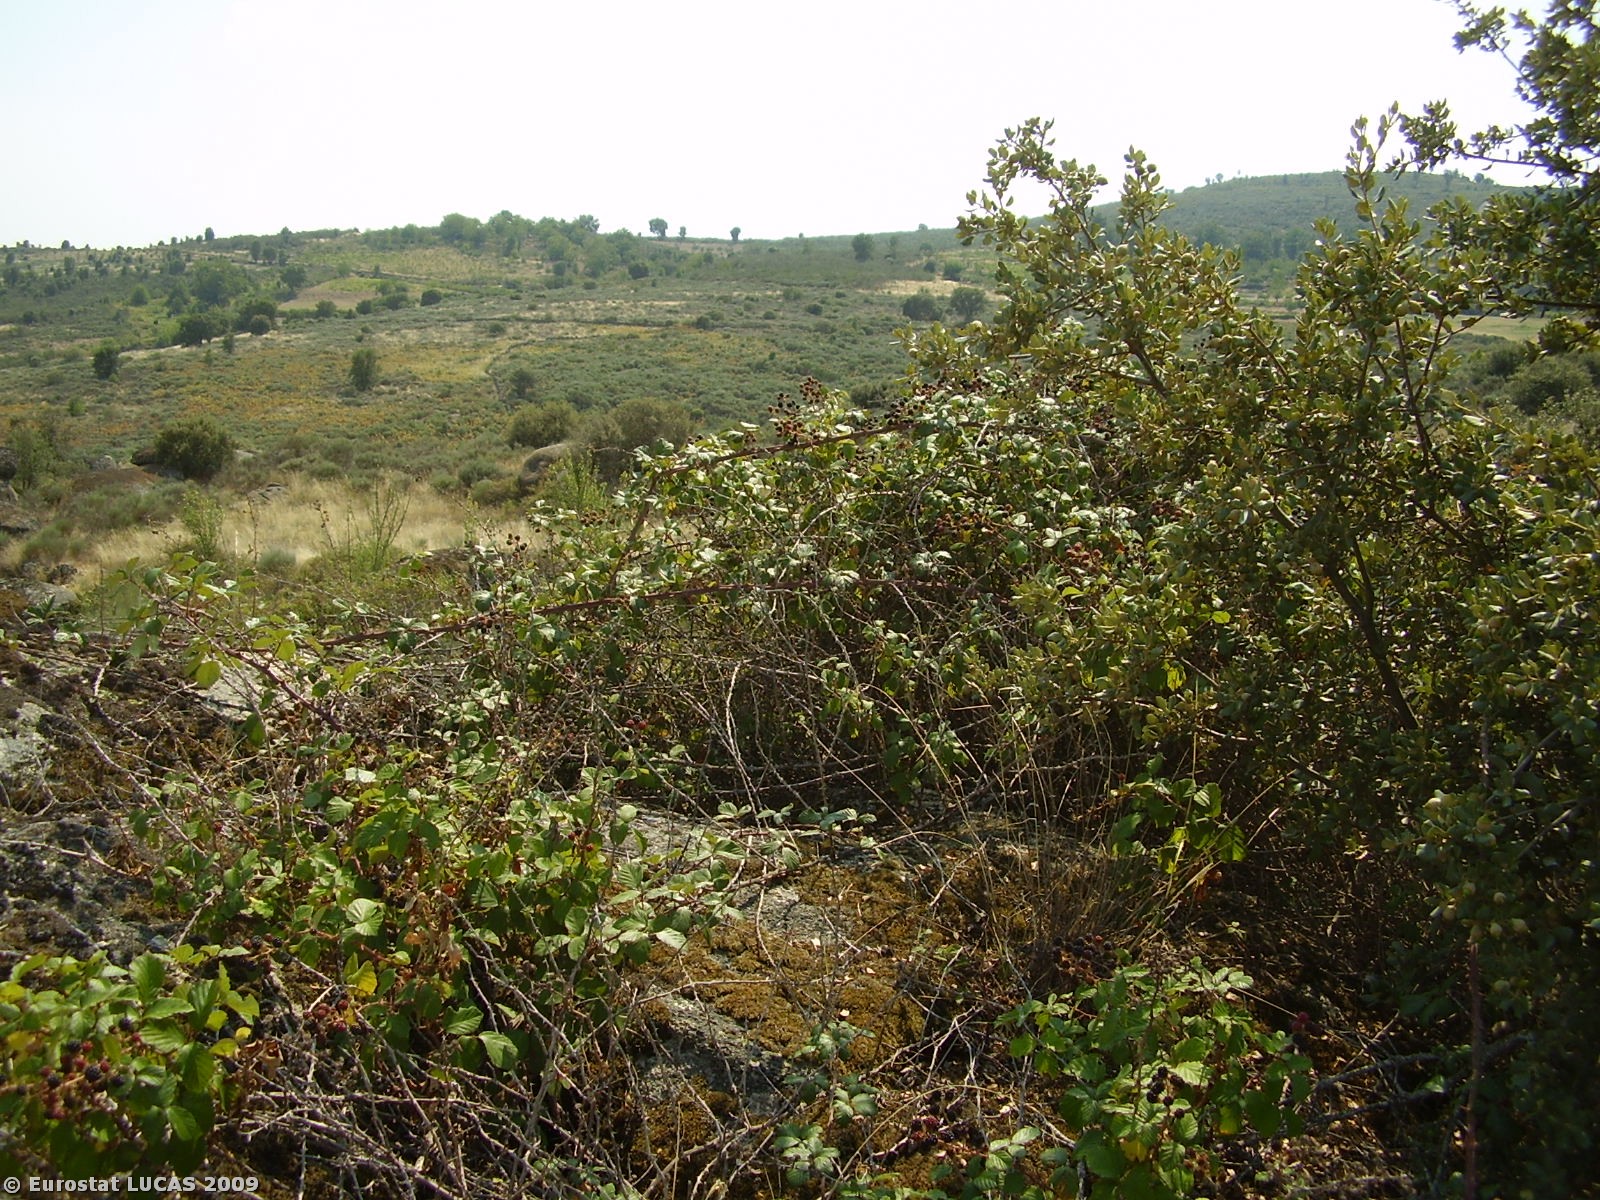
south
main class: Grassland
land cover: Grassland with sparse tree/shrub cover
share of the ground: > 75 %
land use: Fallow land
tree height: > 5 m
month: August
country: PT
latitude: 41.1689
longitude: -6.7789
